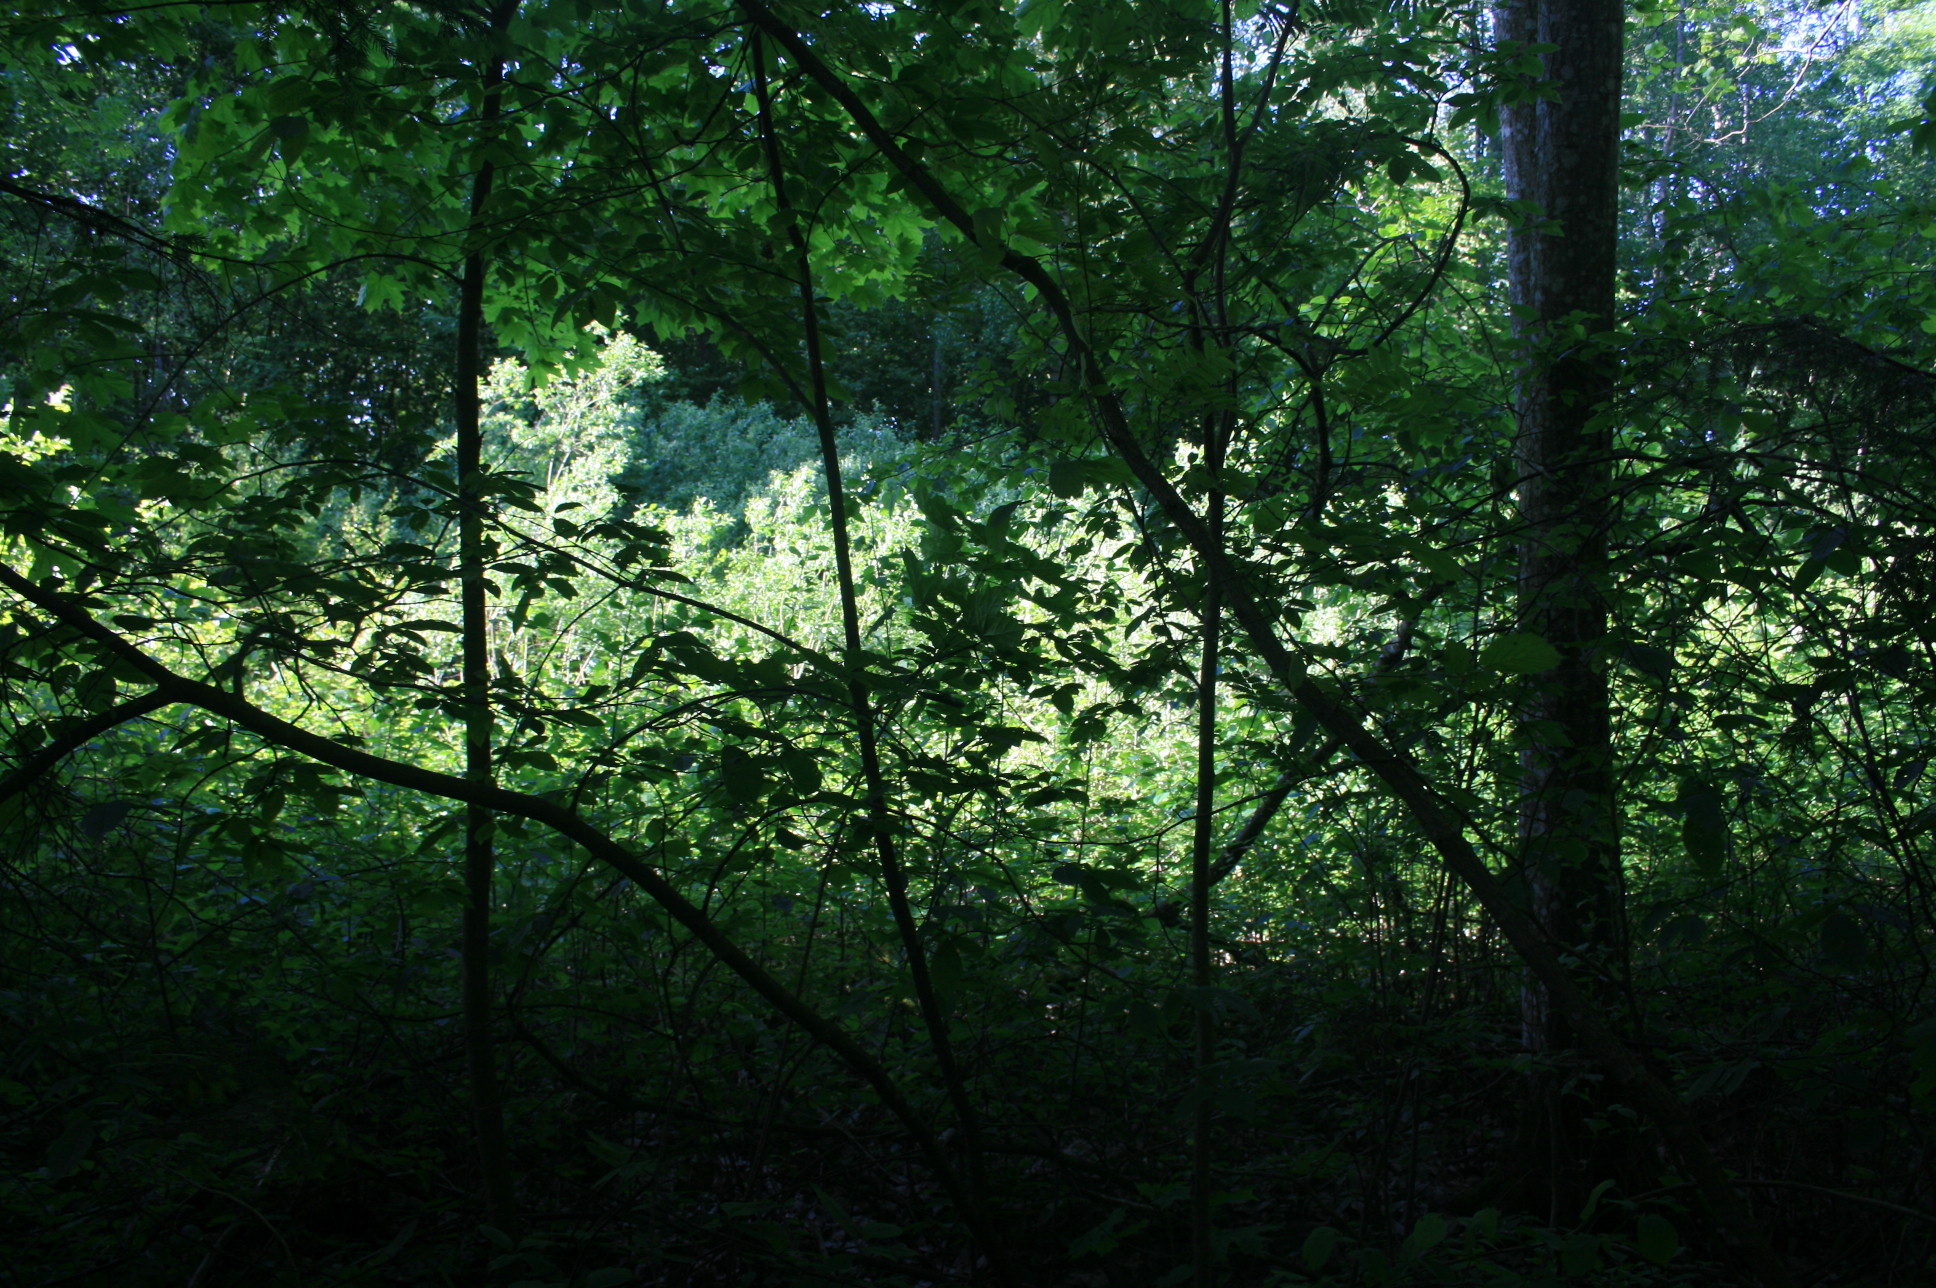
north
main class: Woodland
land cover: Broadleaved woodland
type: non-riverine alder, birch or aspen forest
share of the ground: > 75 %
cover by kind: broadleaved forest trees 95 %, herbaceous plants 5 %
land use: Forestry
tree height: > 5 m
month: June
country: LT
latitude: 56.0192
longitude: 22.0357
